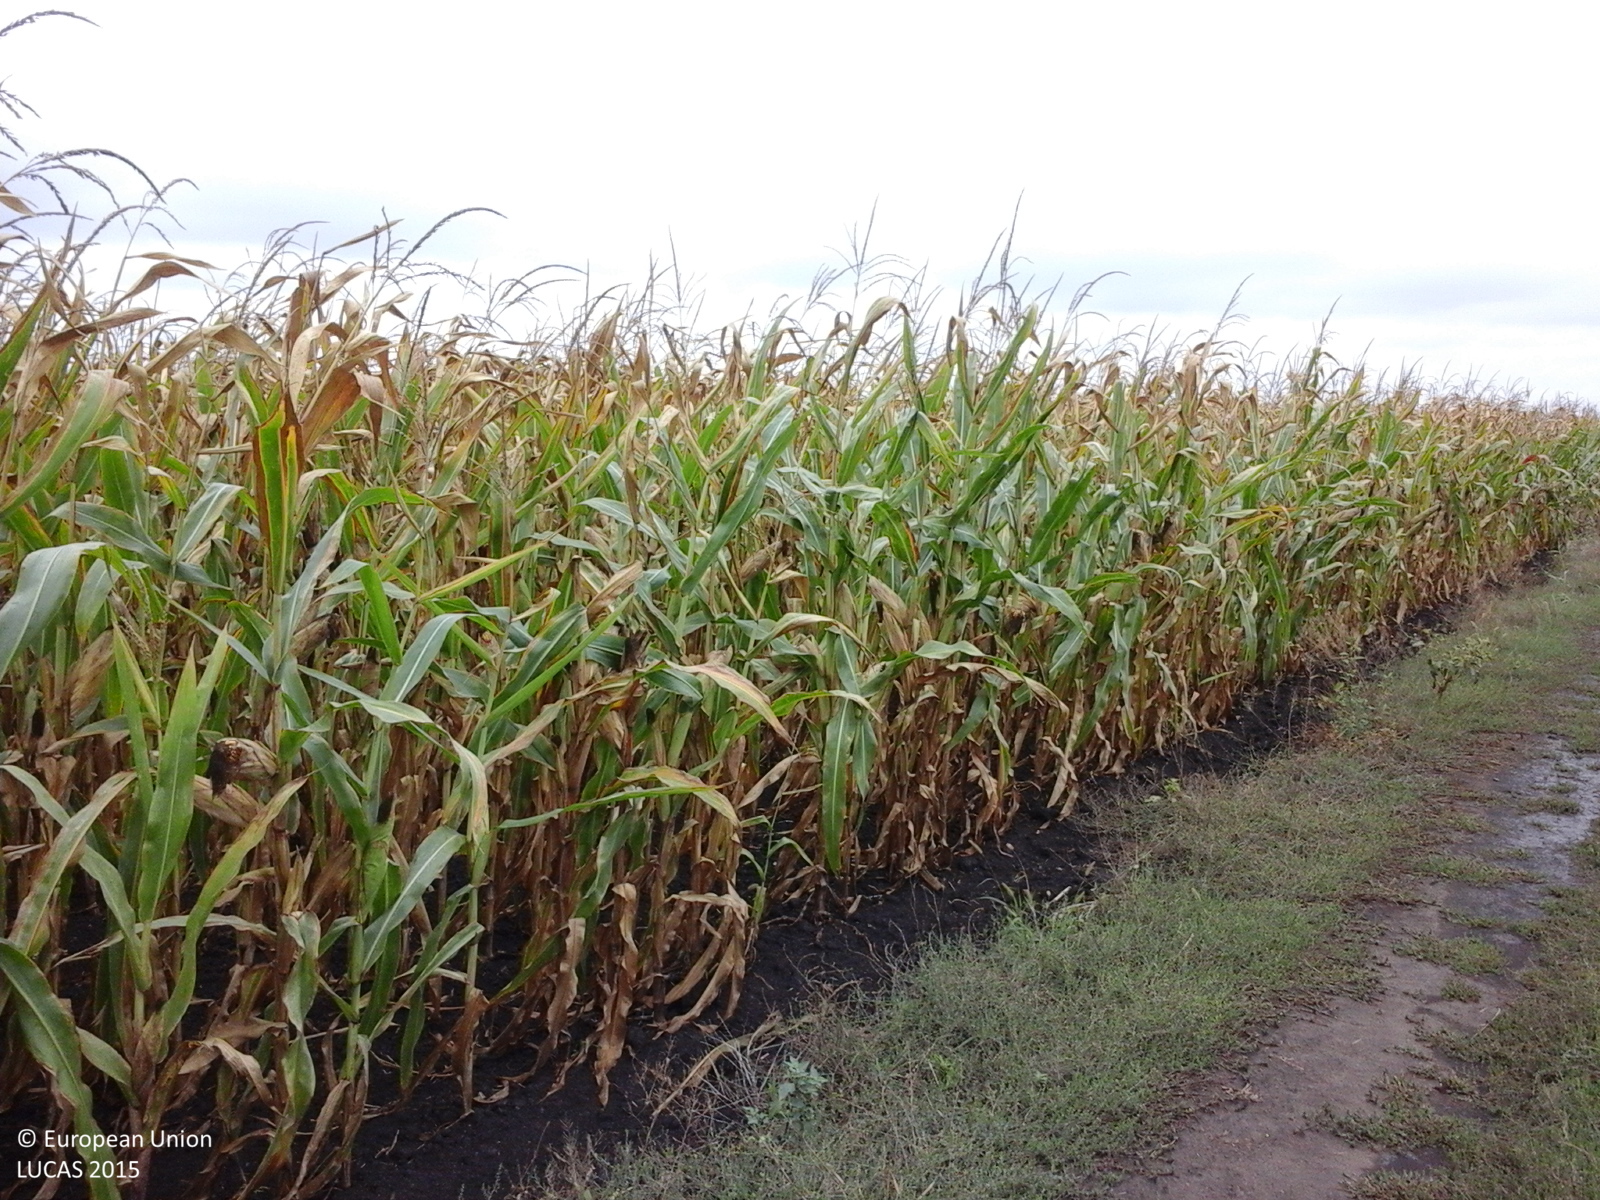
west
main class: Cropland
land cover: Maize
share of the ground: > 75 %
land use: Agriculture (excluding fallow land and kitchen gardens)
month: August
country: RO
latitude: 45.8236
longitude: 20.7738
